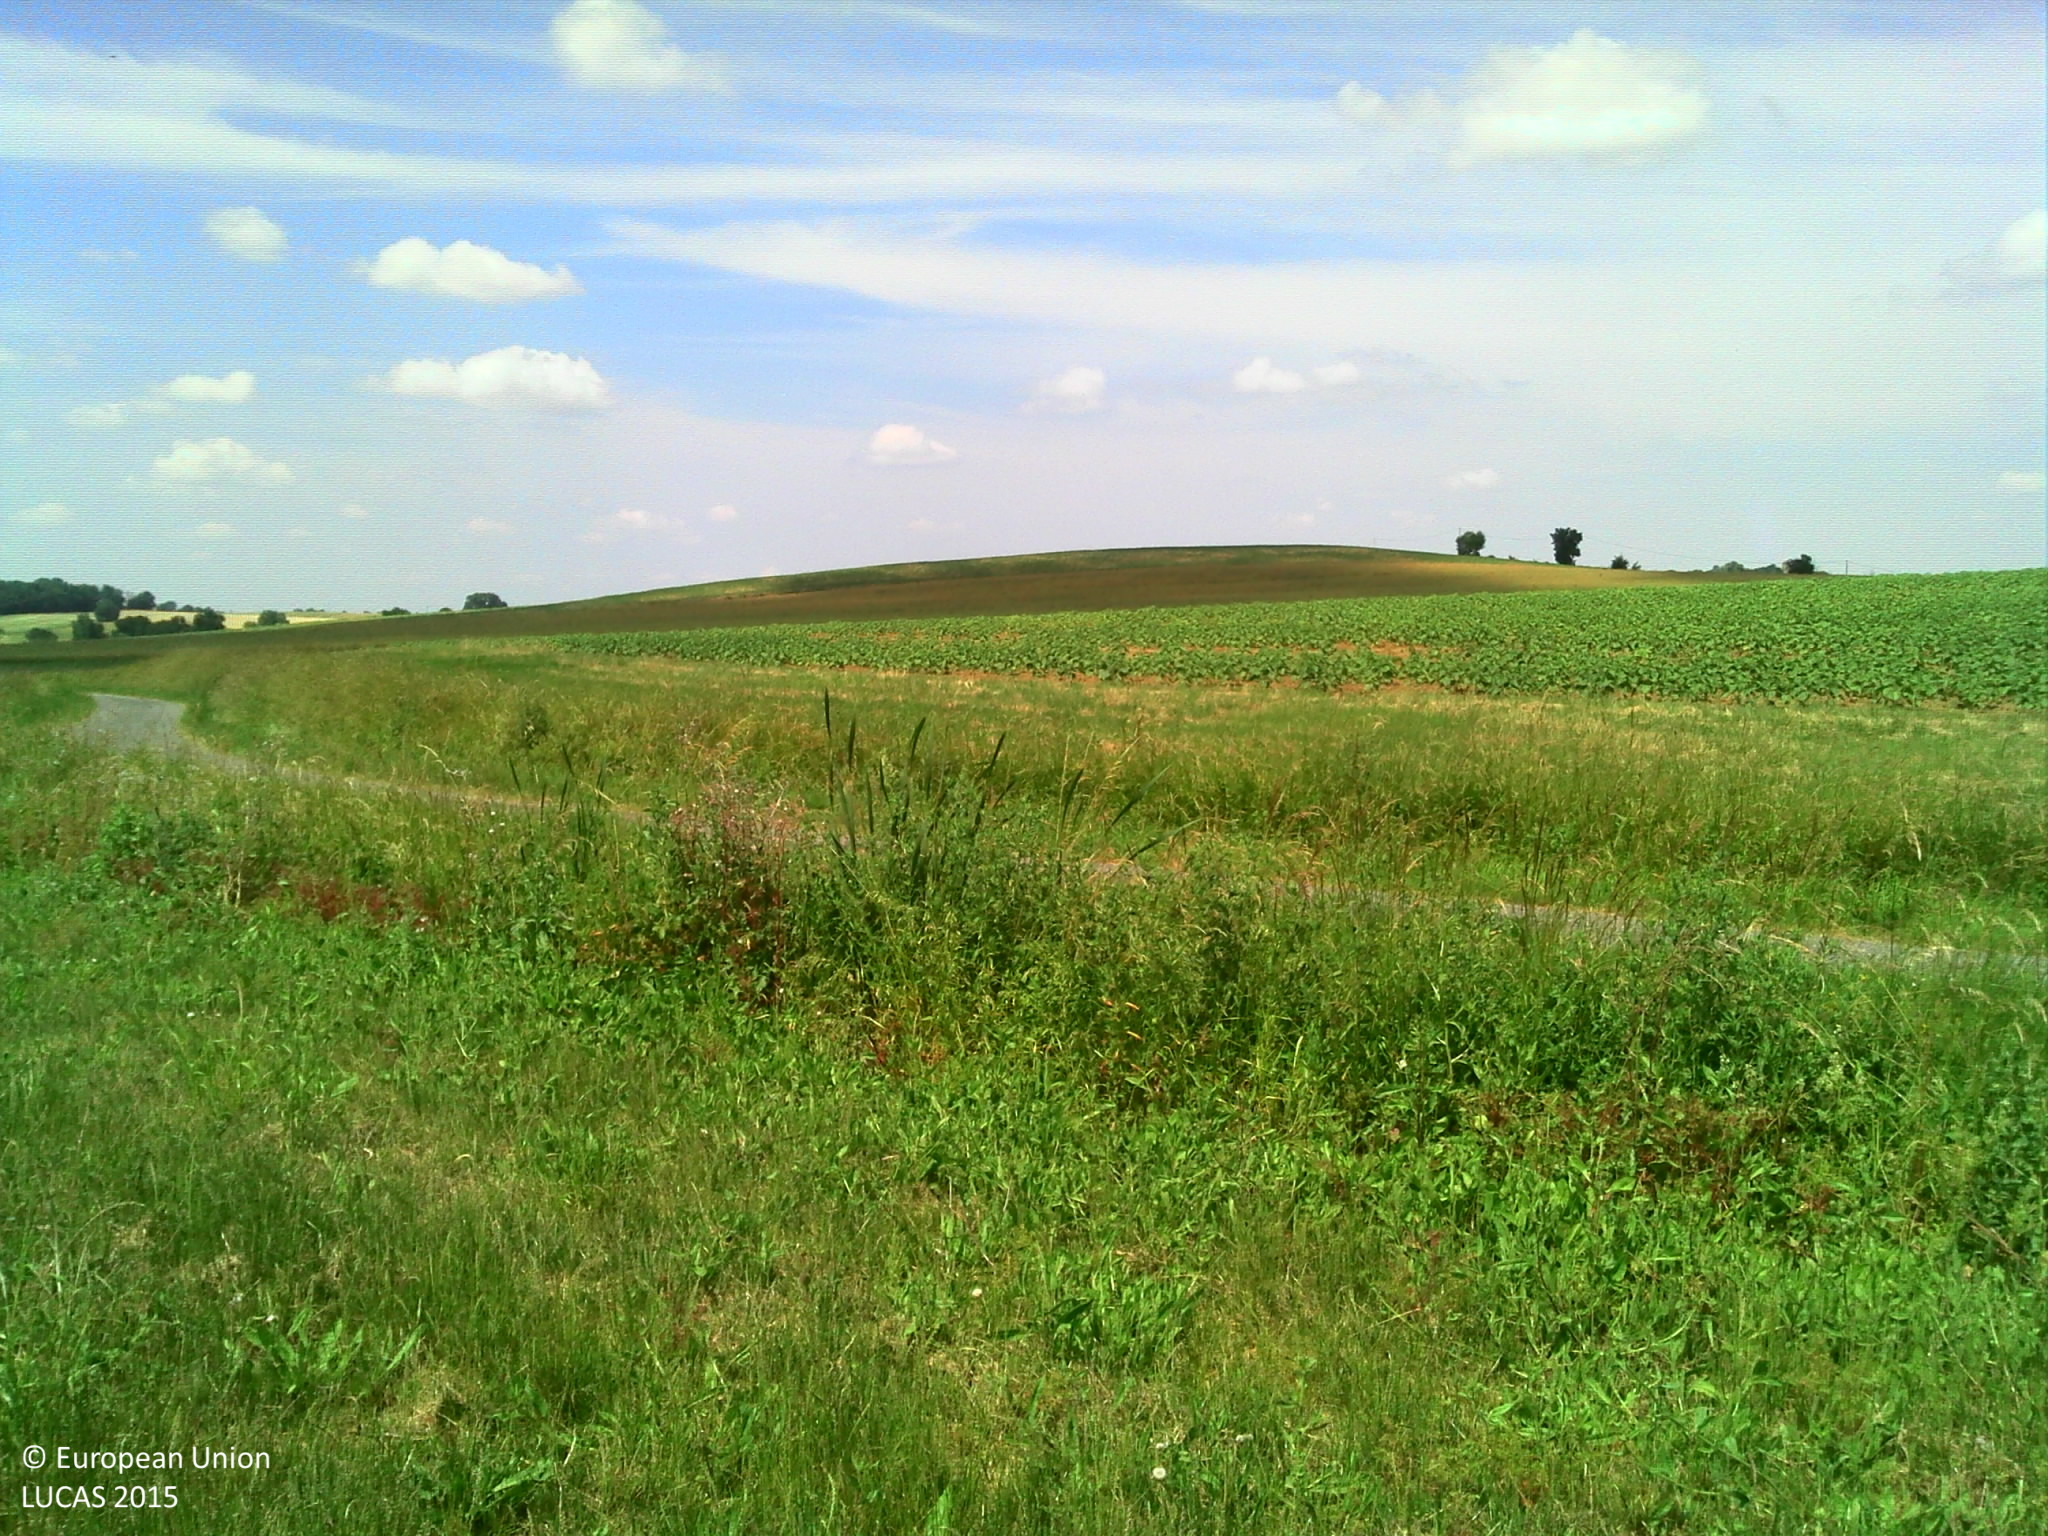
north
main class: Grassland
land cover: Grassland without tree/shrub cover
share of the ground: > 75 %
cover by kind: herbaceous plants 100 %
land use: Agriculture (excluding fallow land and kitchen gardens)
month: June
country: FR
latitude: 43.7547
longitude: 0.7453
